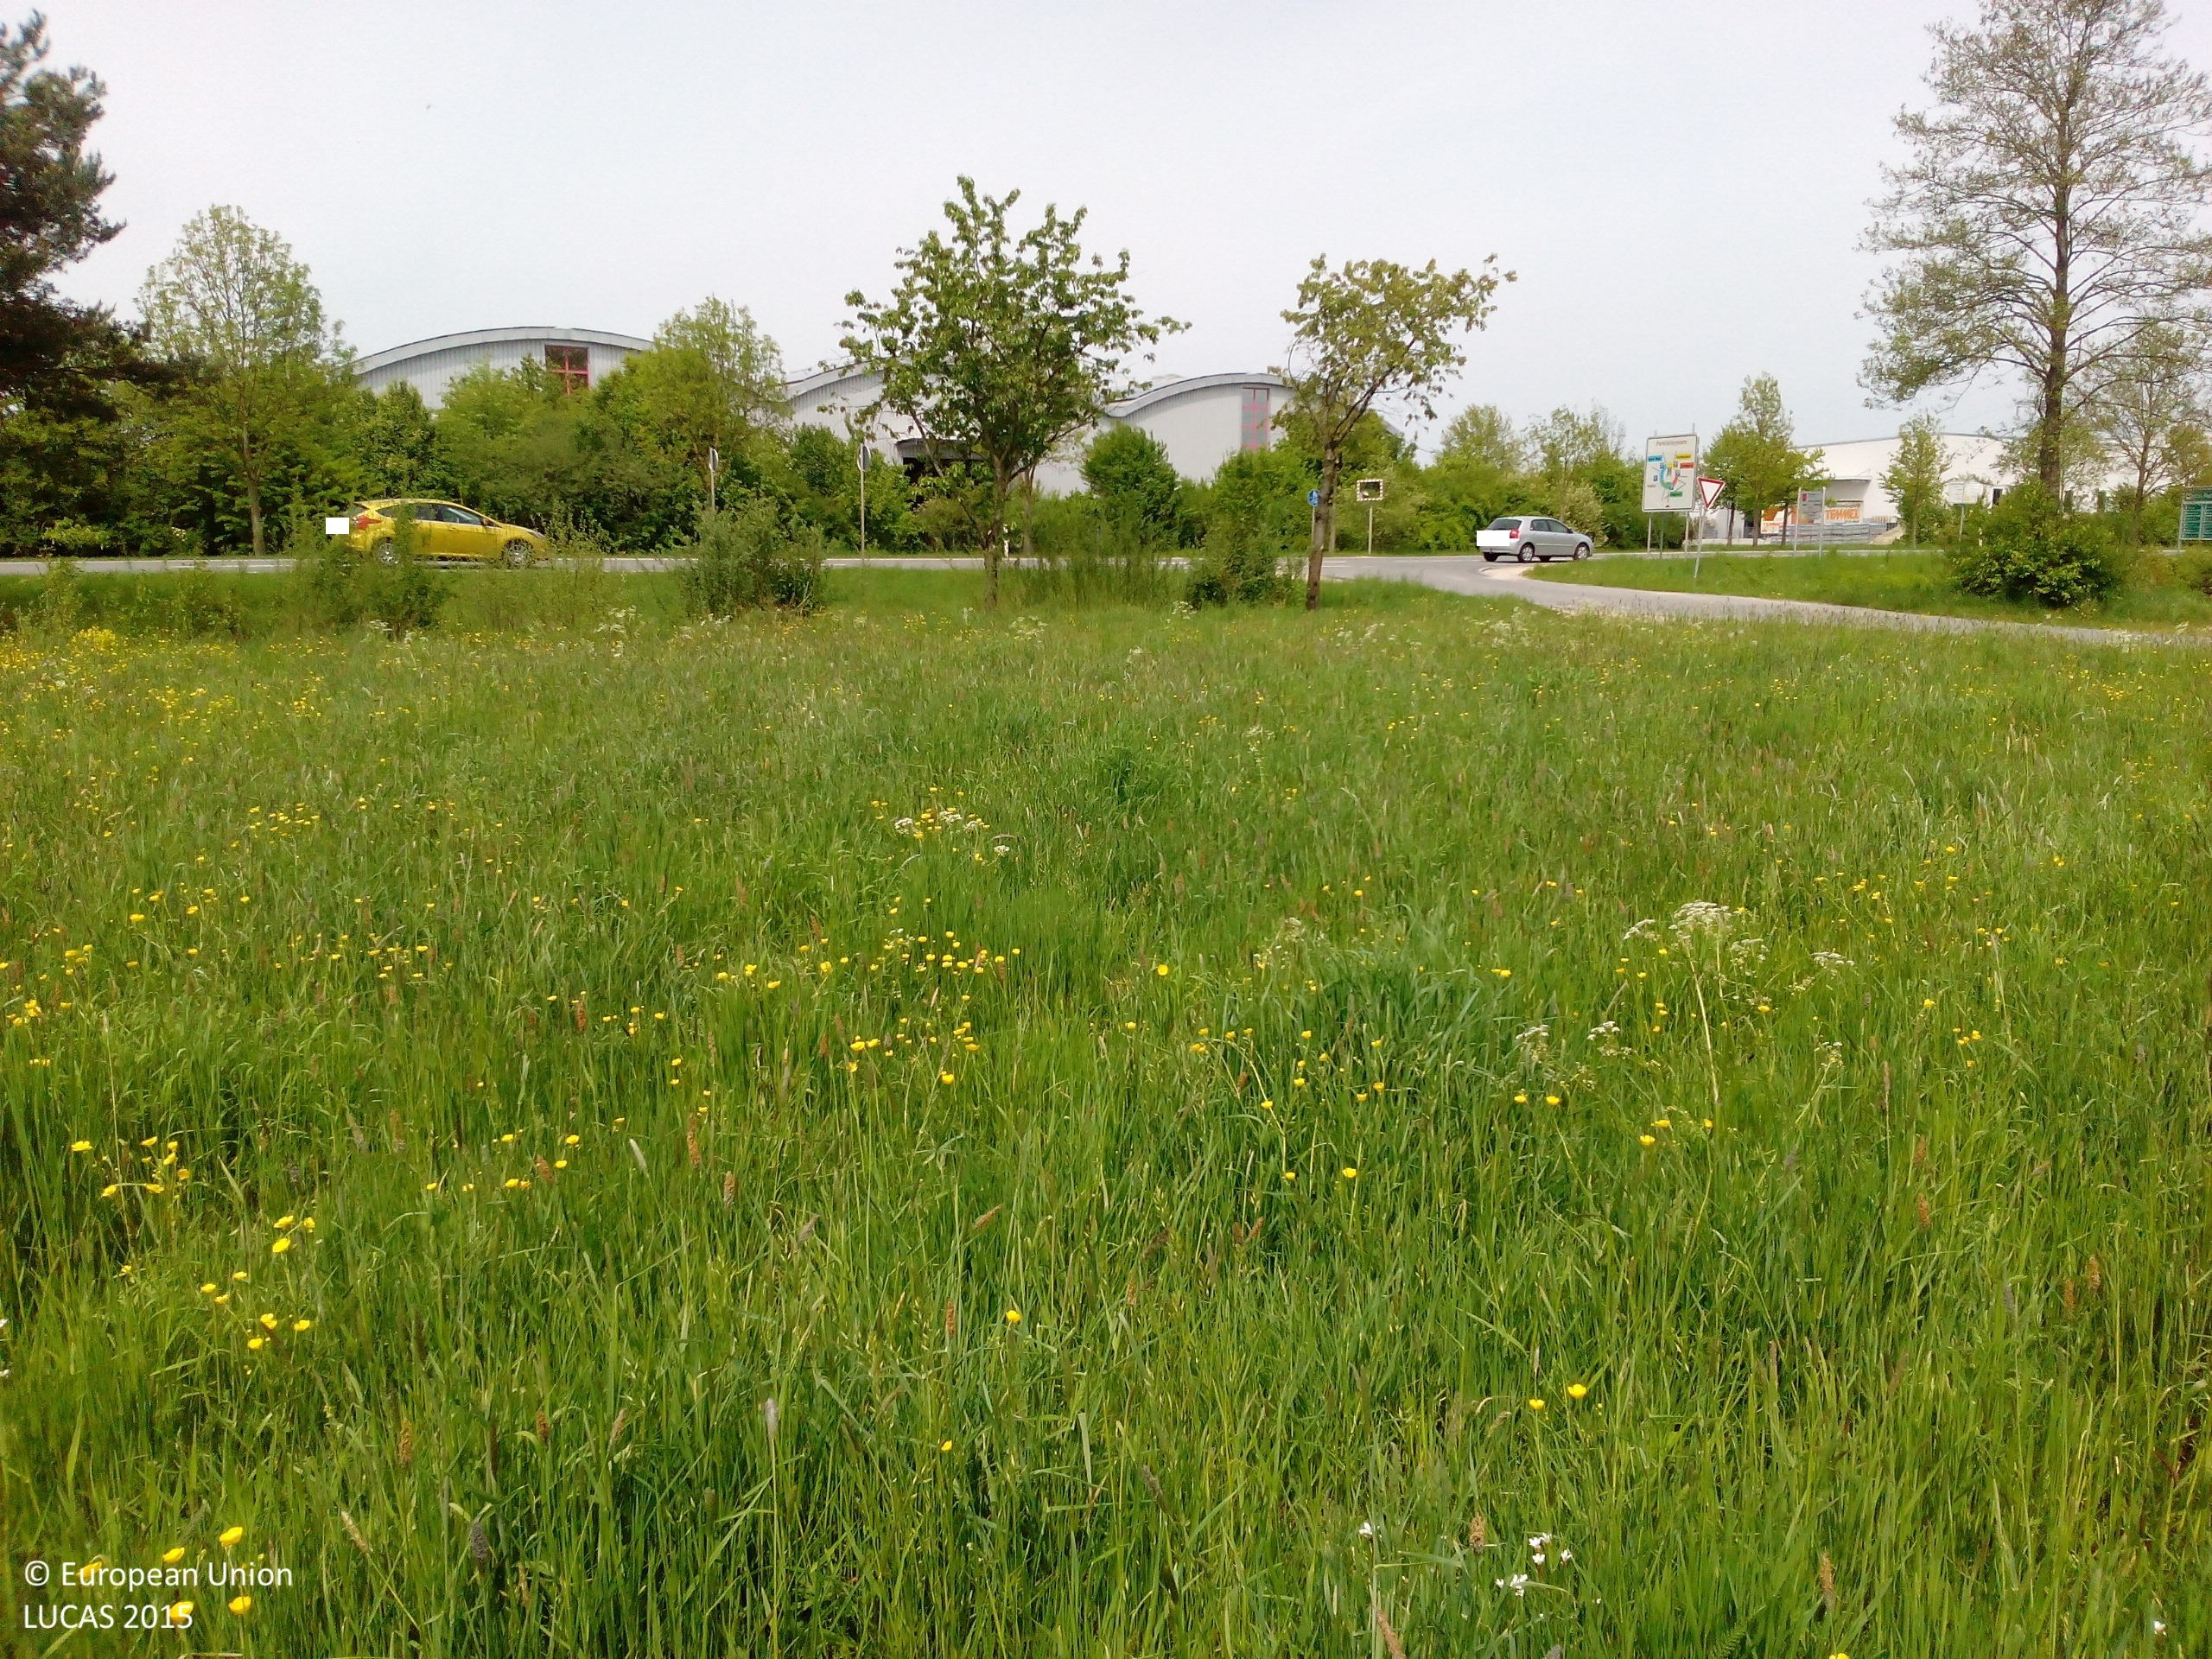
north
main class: Grassland
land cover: Grassland without tree/shrub cover
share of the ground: > 75 %
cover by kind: herbaceous plants 90 %, unconsolidated bare surface 10 %
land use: Agriculture (excluding fallow land and kitchen gardens)
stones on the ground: < 10 %
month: May
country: DE
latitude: 49.2578
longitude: 11.4422
